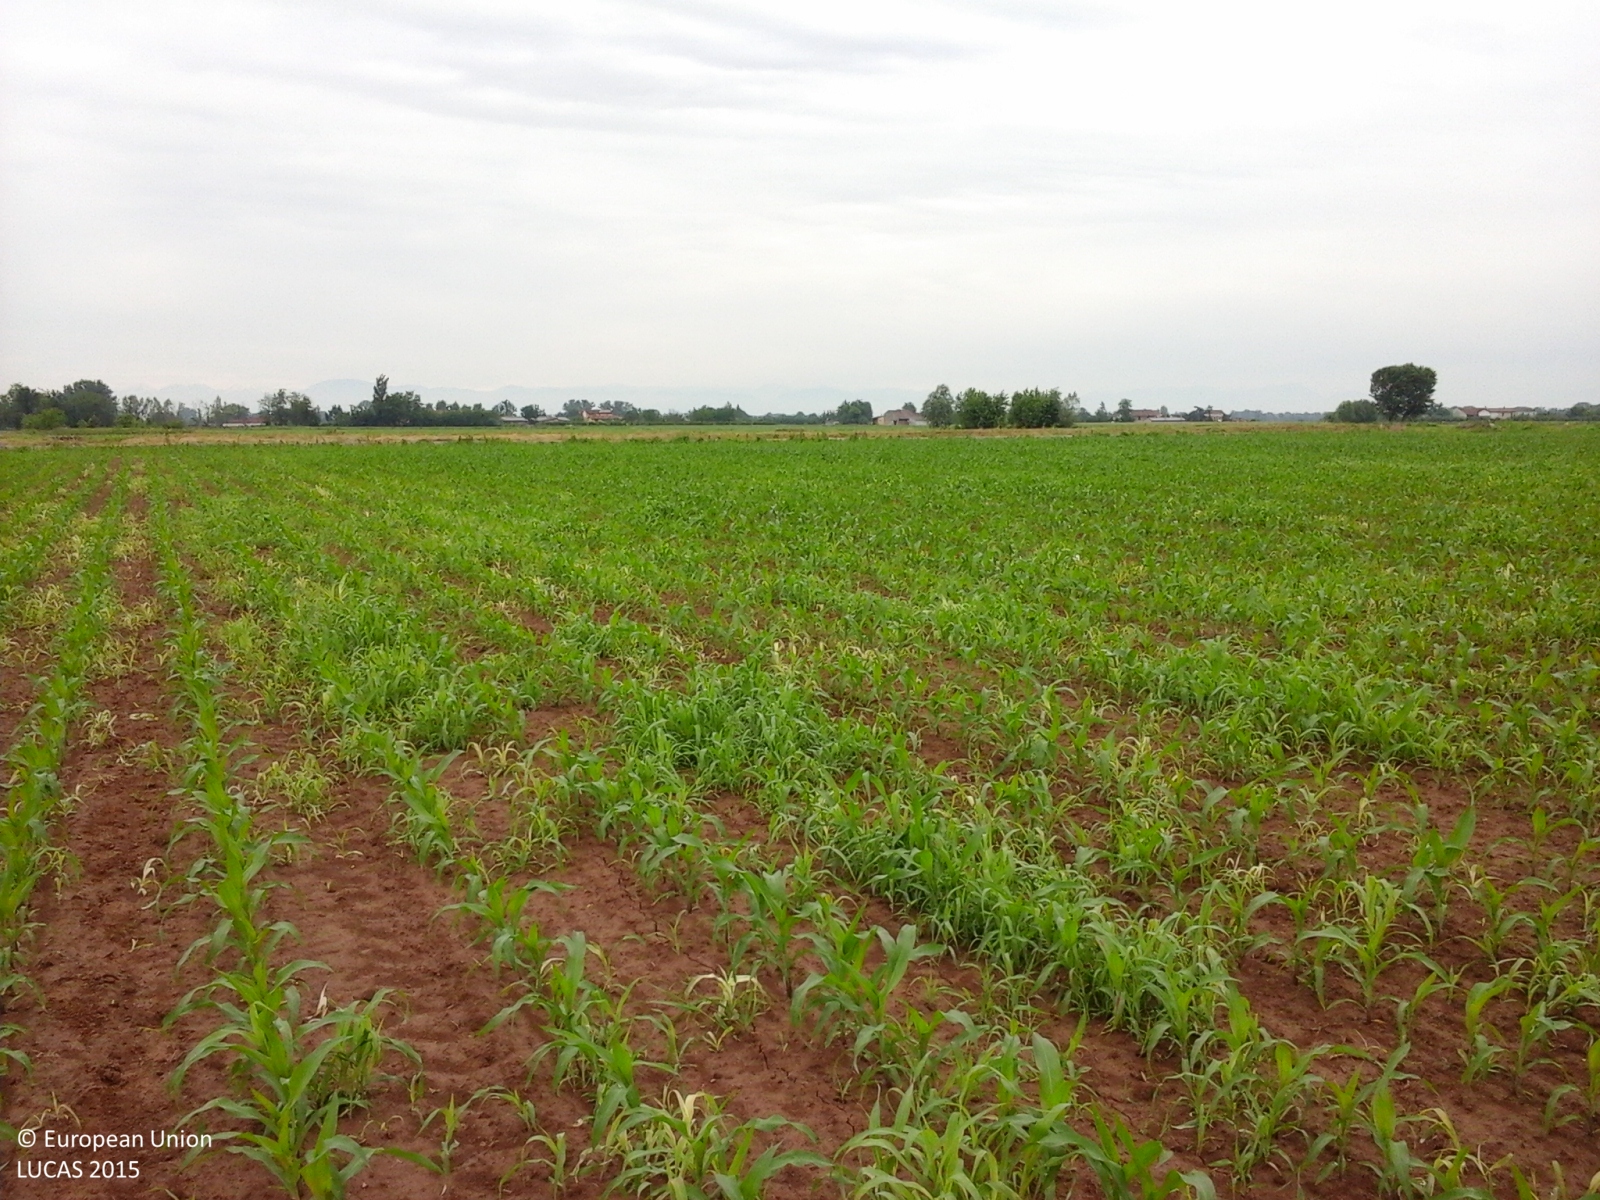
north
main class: Cropland
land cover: Maize
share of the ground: 50 - 75 %
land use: Agriculture (excluding fallow land and kitchen gardens)
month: May
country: IT
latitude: 45.2159
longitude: 10.1906
